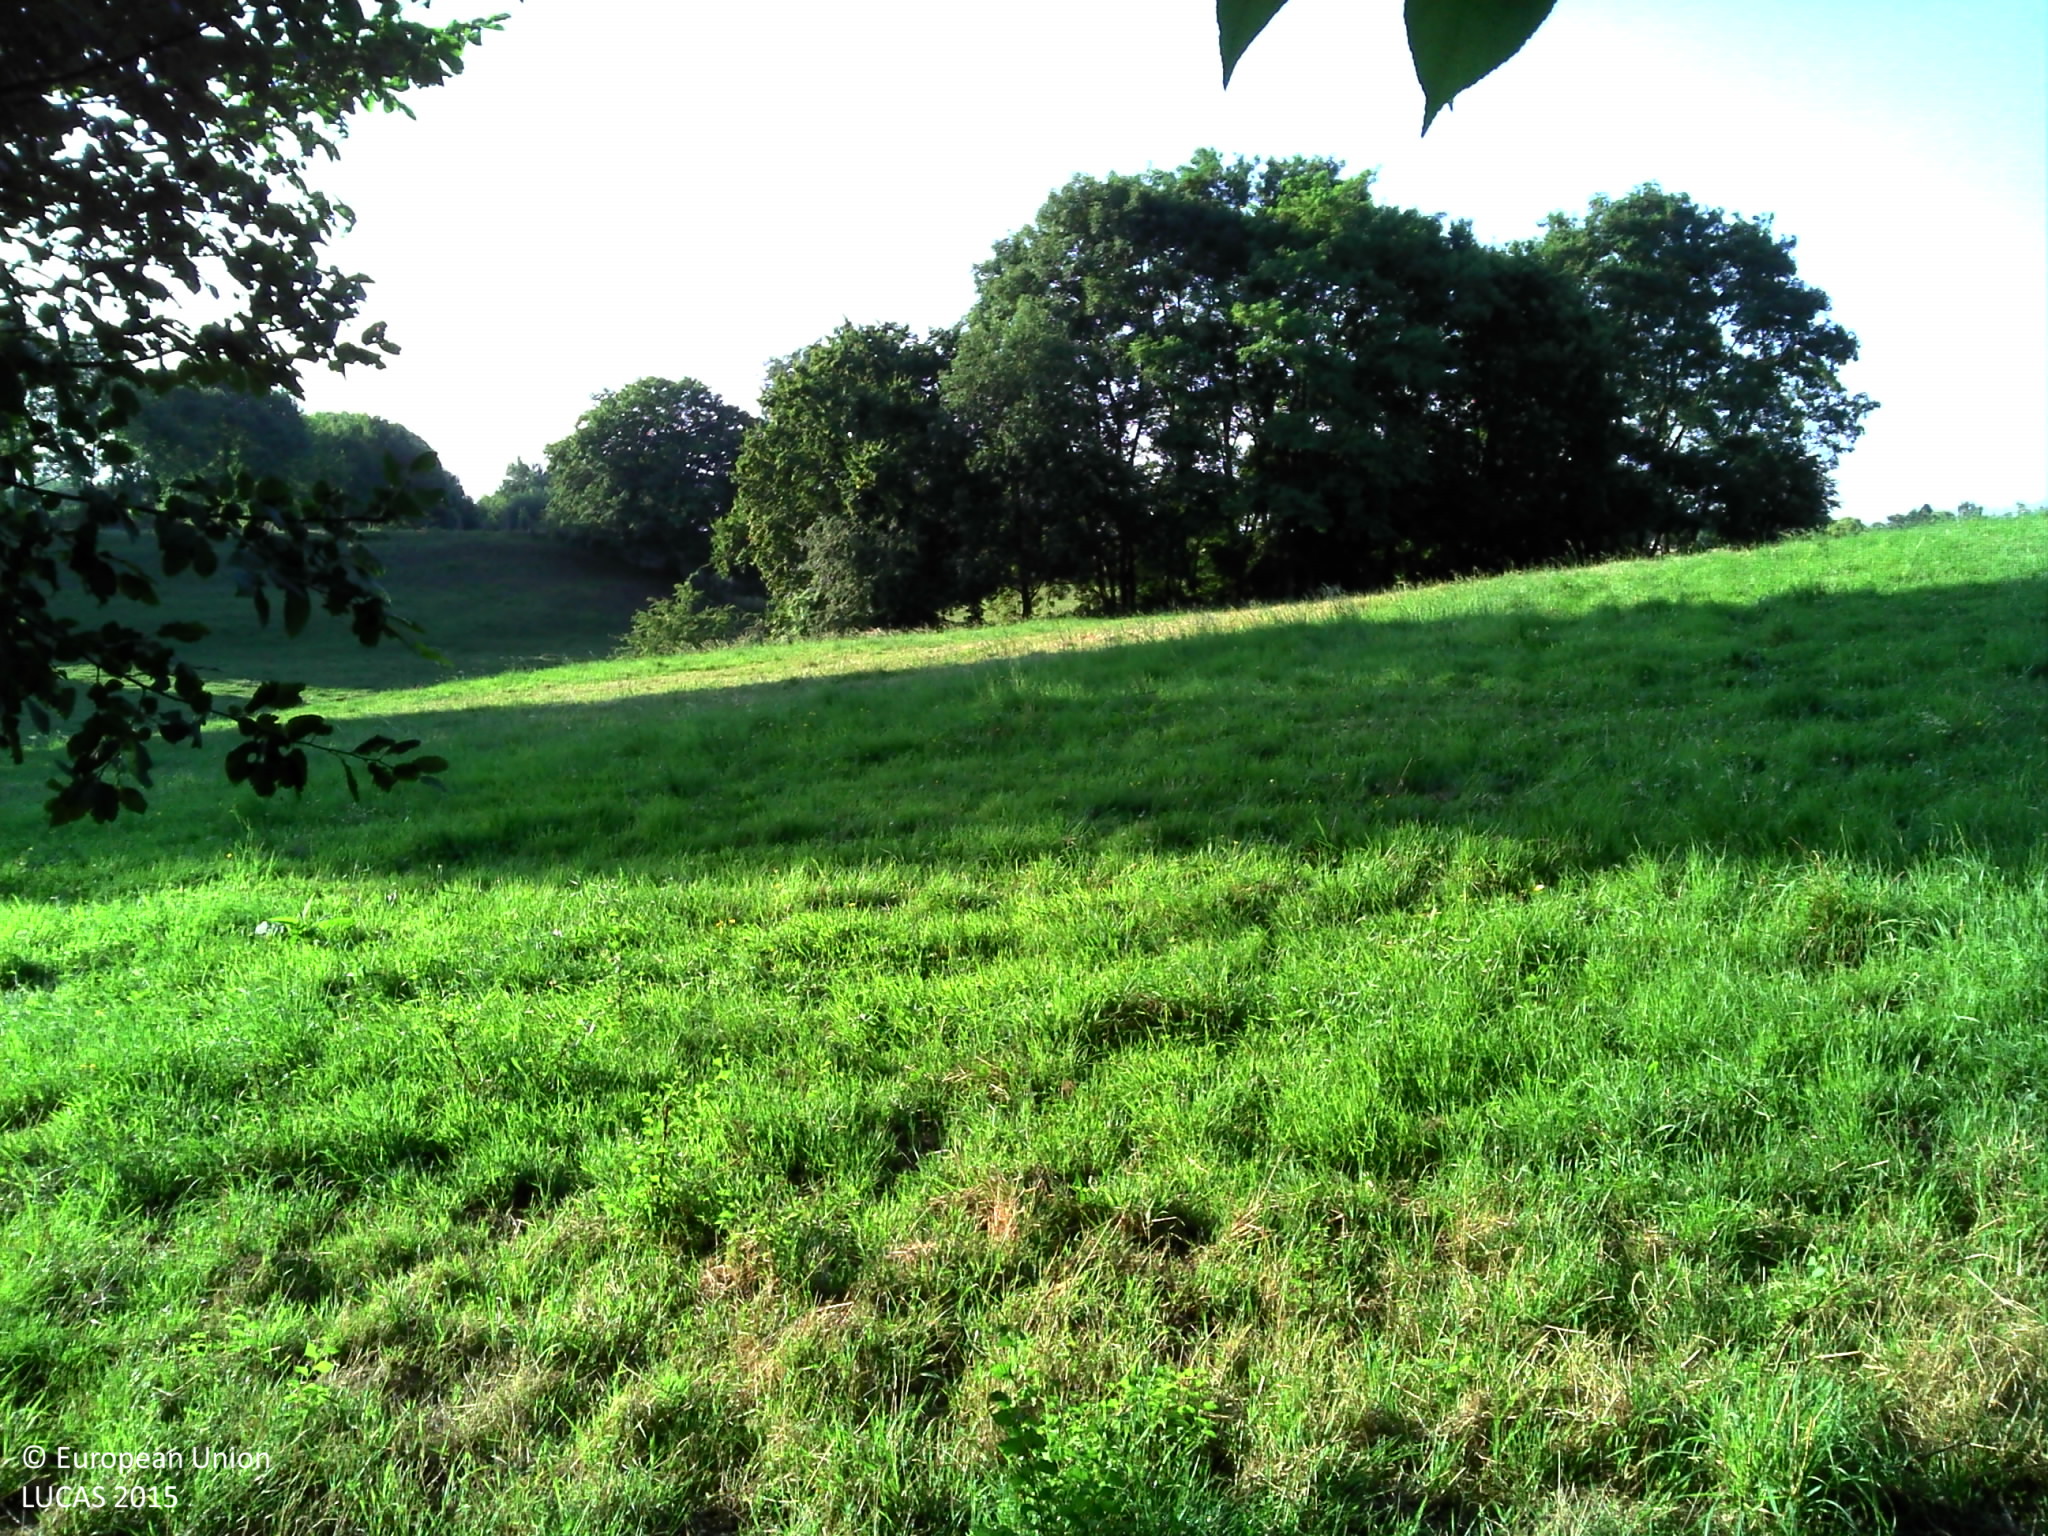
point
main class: Grassland
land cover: Grassland without tree/shrub cover
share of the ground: > 75 %
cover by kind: herbaceous plants 100 %
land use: Agriculture (excluding fallow land and kitchen gardens)
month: July
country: BE
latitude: 50.4609
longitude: 4.0357
